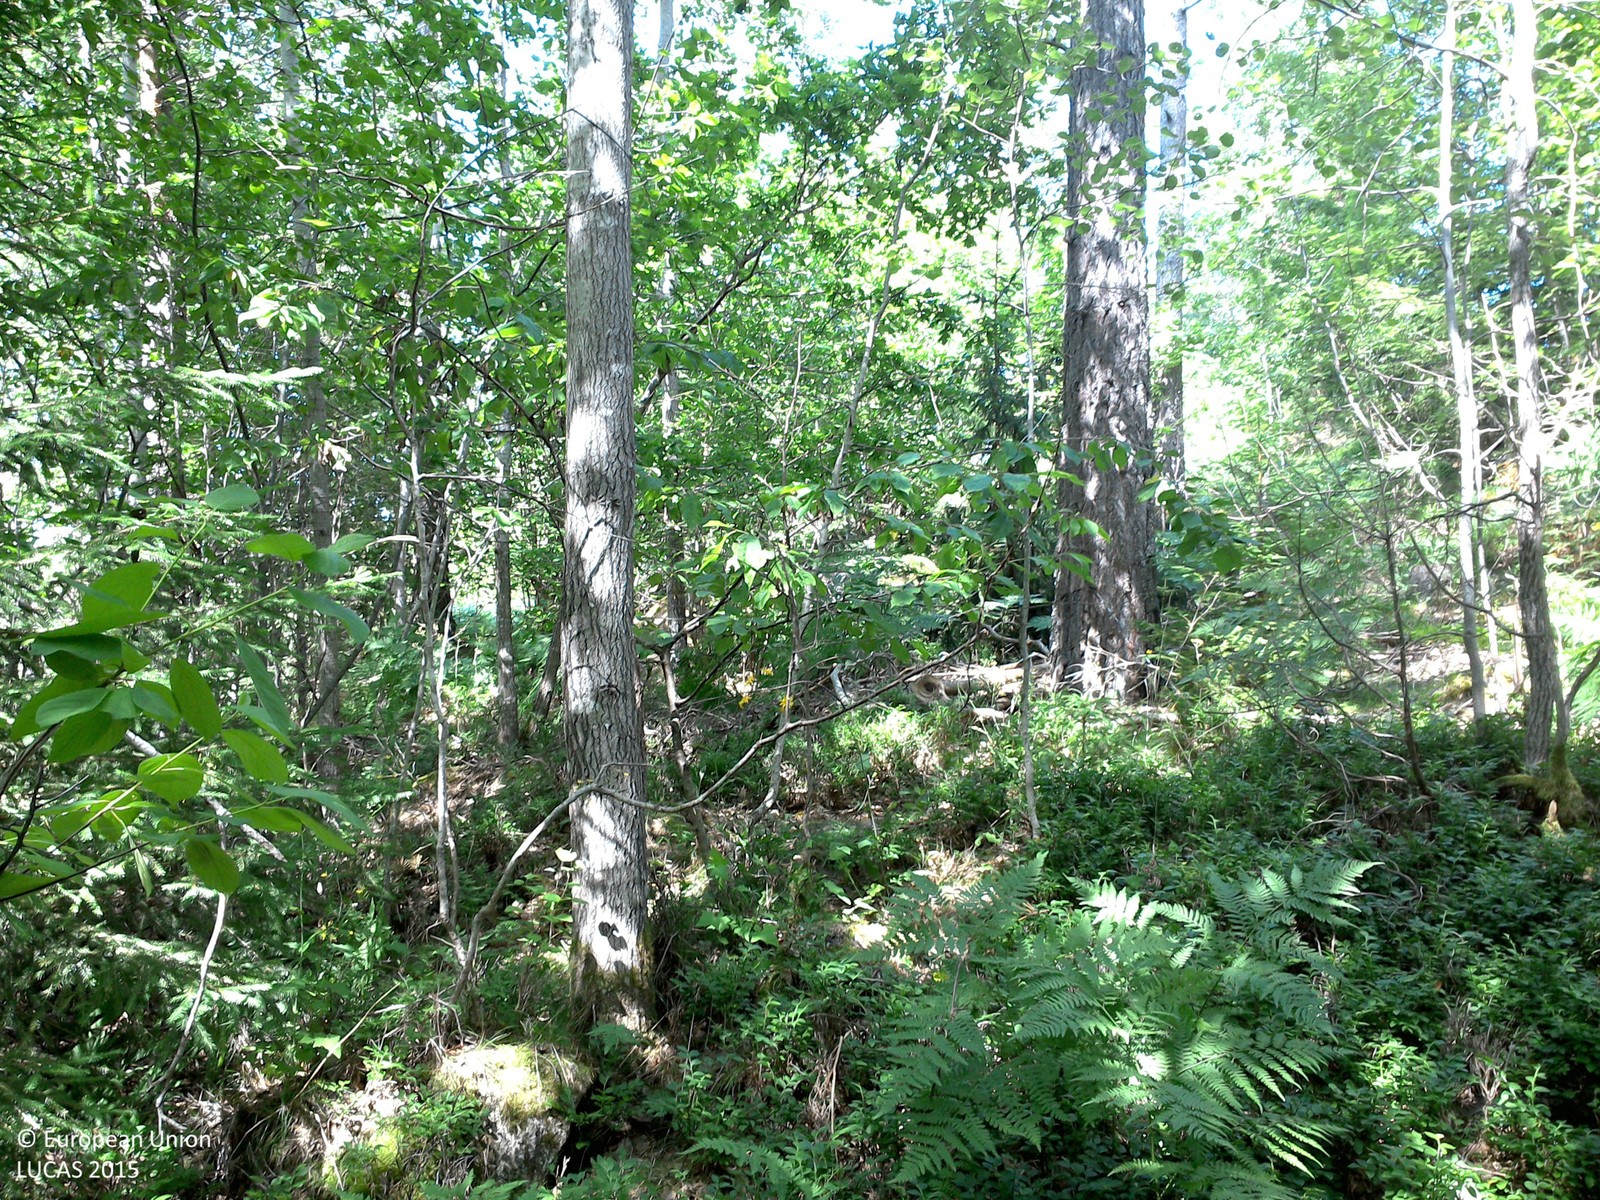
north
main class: Woodland
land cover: Broadleaved woodland
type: boreal forest
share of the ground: > 75 %
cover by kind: broadleaved forest trees 80 %, herbaceous plants 20 %
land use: Forestry
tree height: > 5 m
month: July
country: SE
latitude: 58.1039
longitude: 14.6268
